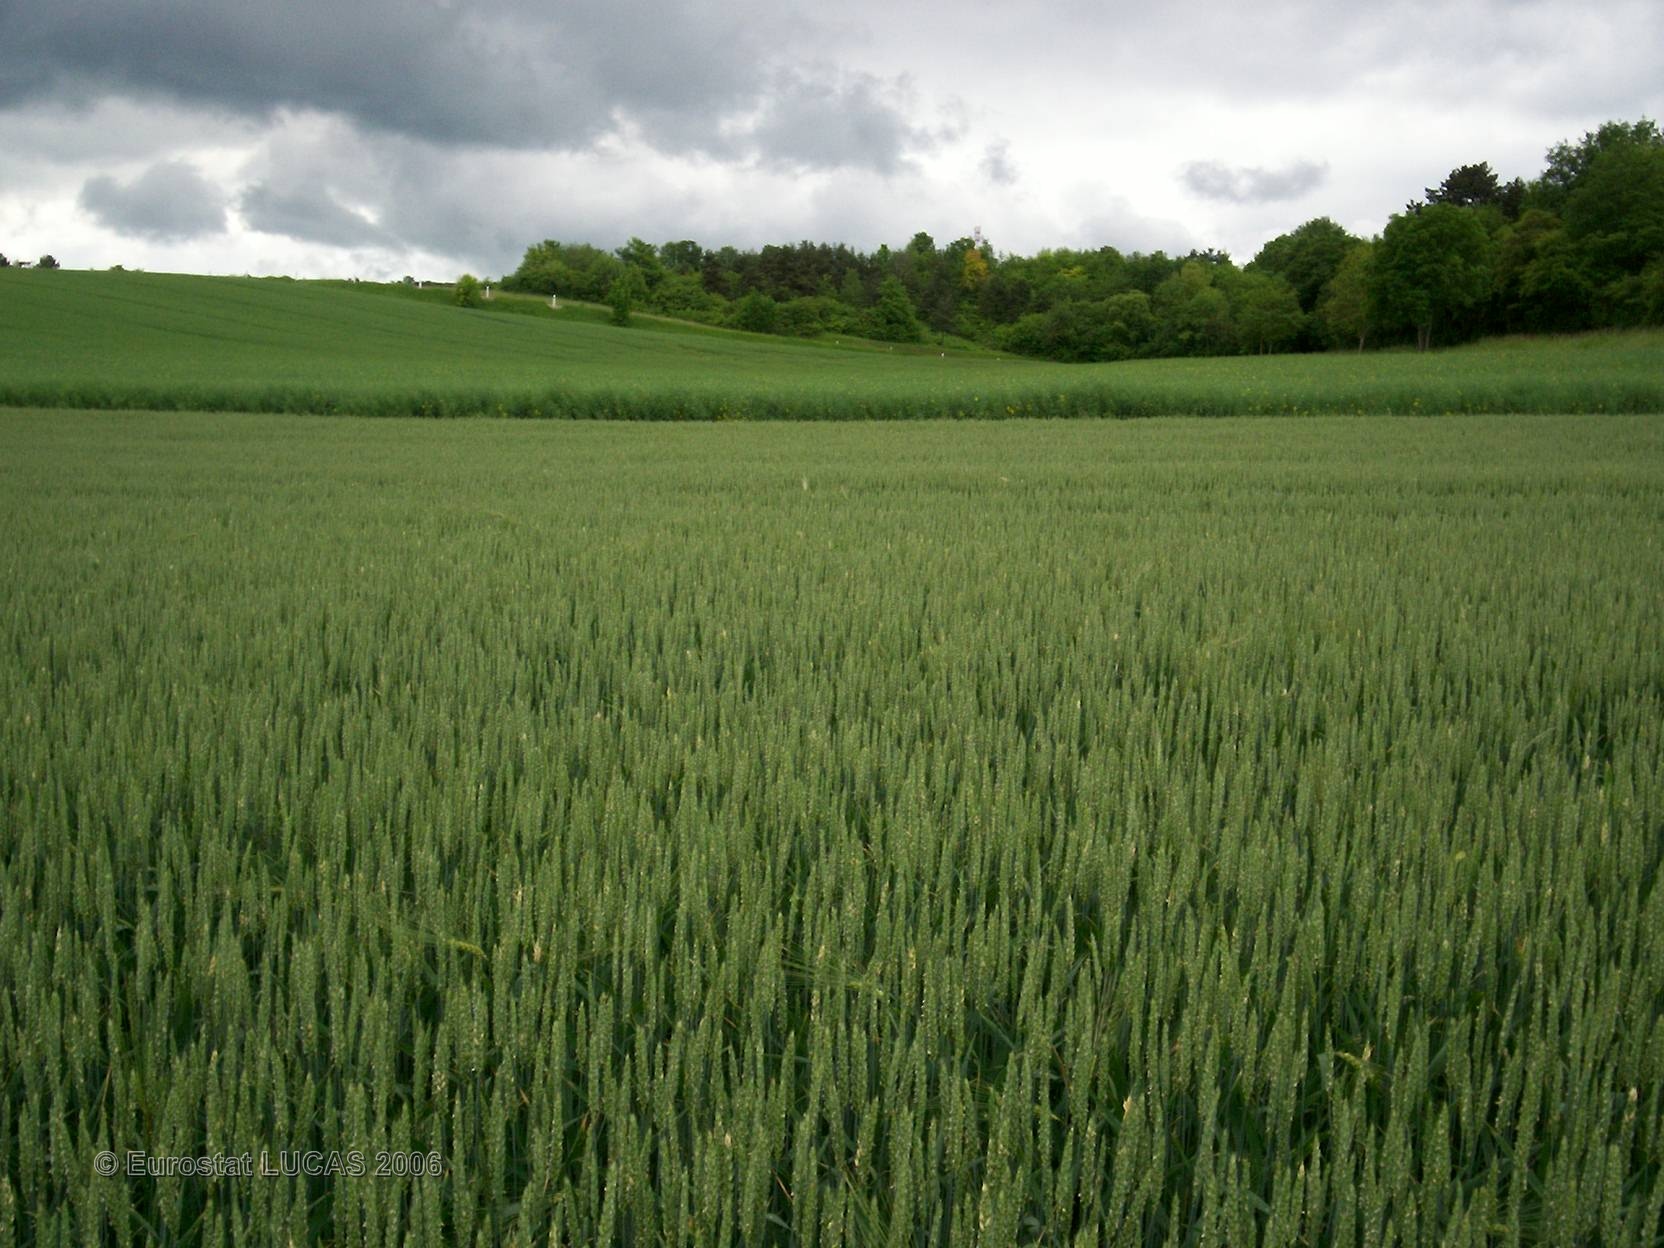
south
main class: Cropland
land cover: Common wheat
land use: Agriculture (excluding fallow land and kitchen gardens)
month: May
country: FR
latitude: 48.3110
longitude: 3.9688
